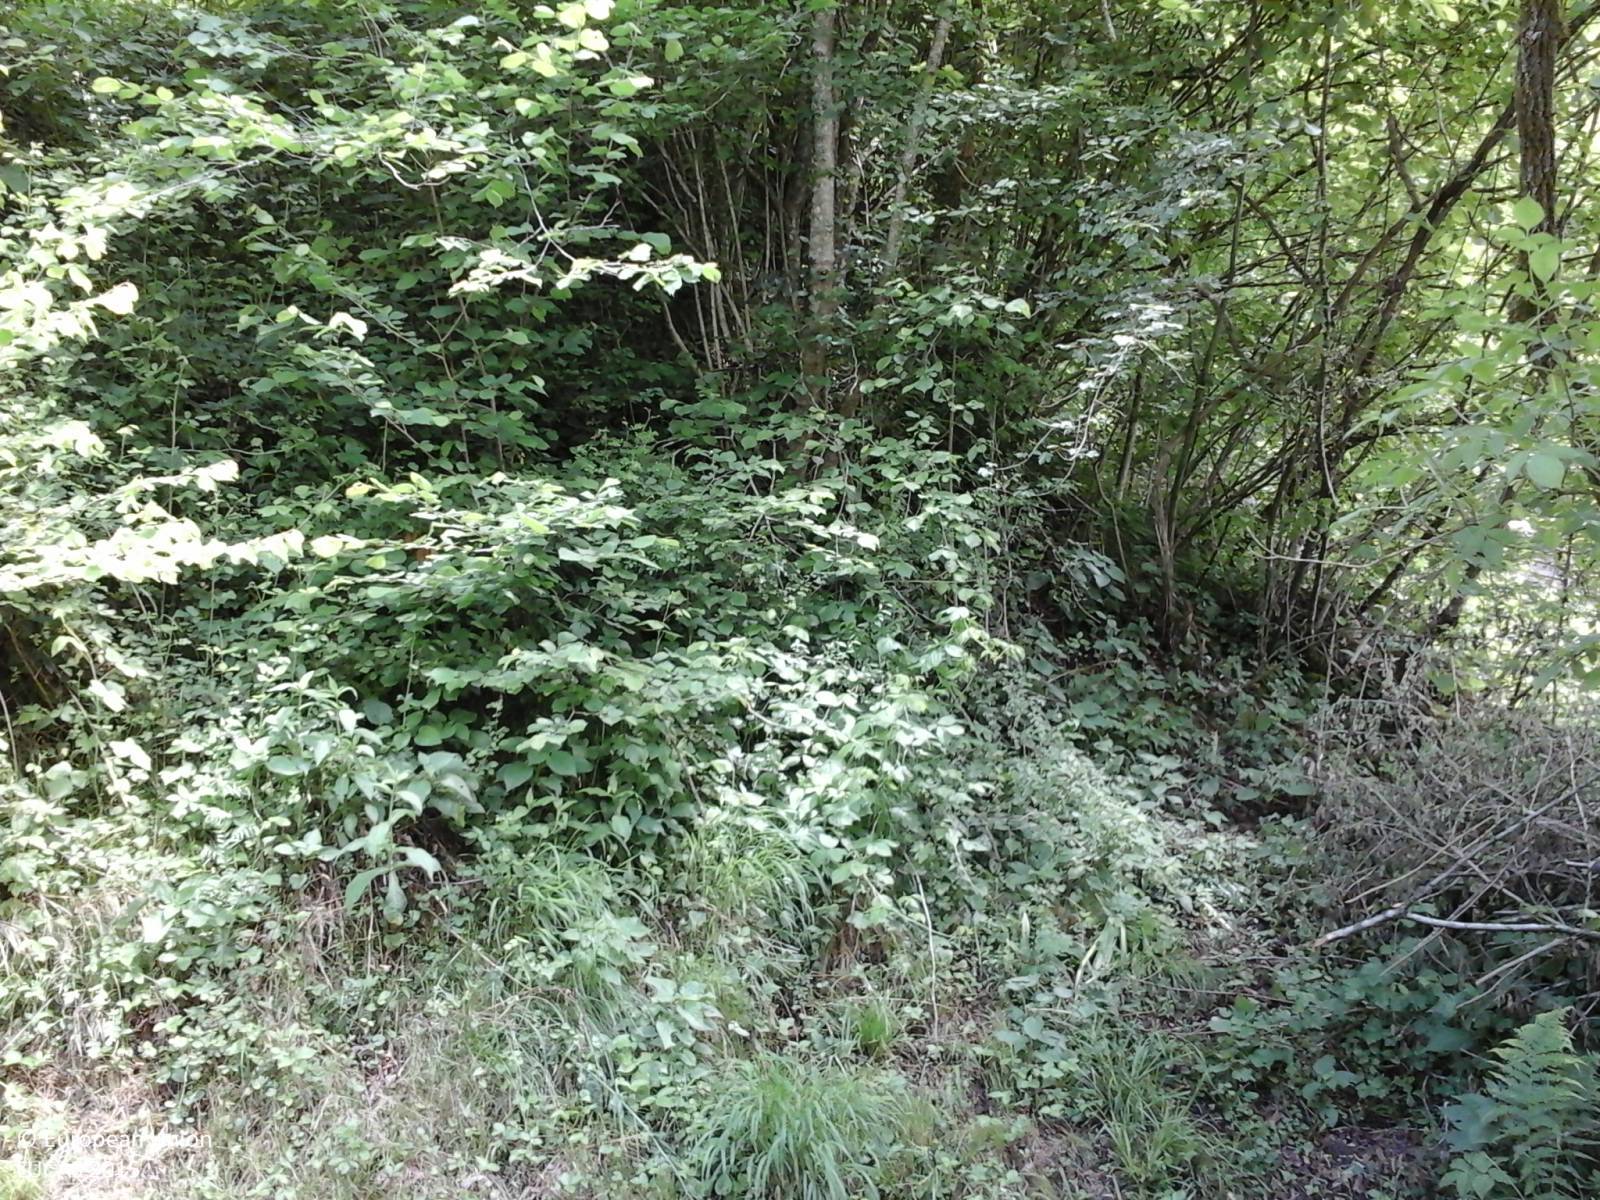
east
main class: Woodland
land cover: Broadleaved woodland
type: thermophilous deciduous forest
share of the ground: > 75 %
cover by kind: broadleaved forest trees 75 %, coniferous forest trees 25 %
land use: Forestry
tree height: > 5 m
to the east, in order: Broadleaved woodland
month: May
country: IT
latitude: 46.2657
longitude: 13.2533
